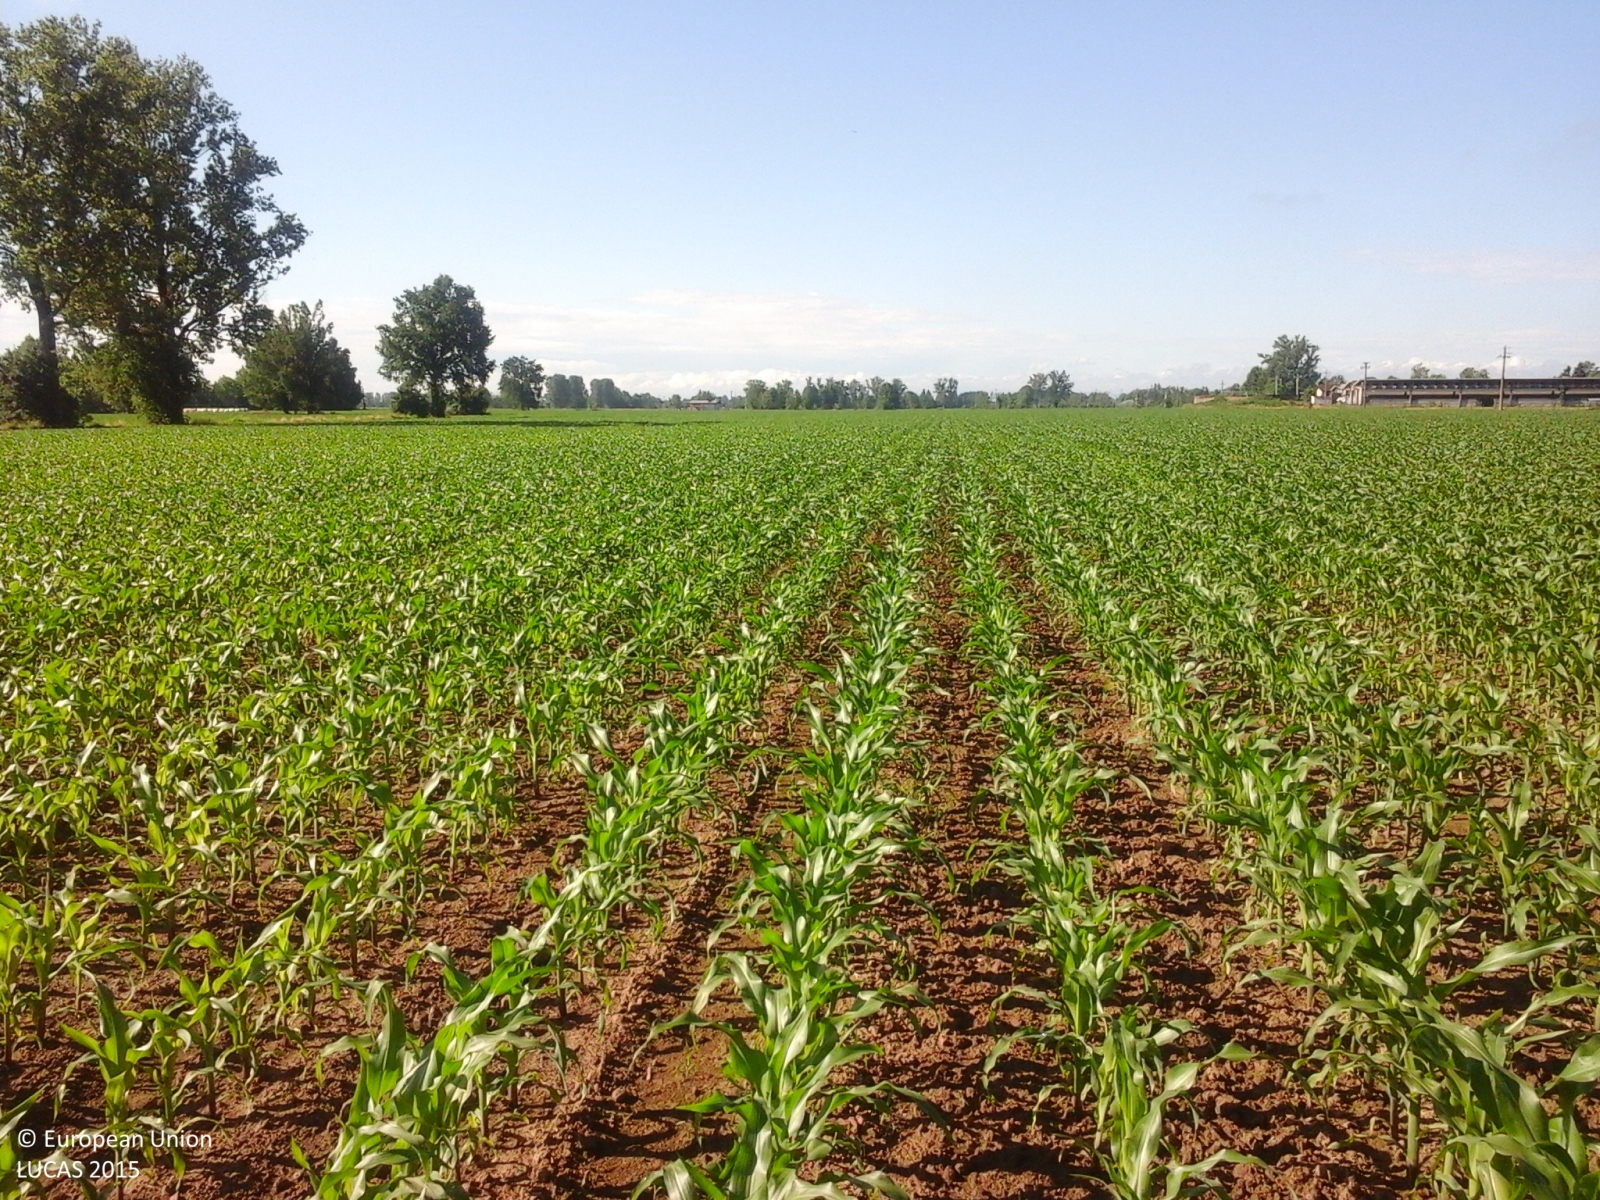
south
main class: Cropland
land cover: Maize
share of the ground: 10 - 25 %
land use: Agriculture (excluding fallow land and kitchen gardens)
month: May
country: IT
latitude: 45.1618
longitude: 10.1651
